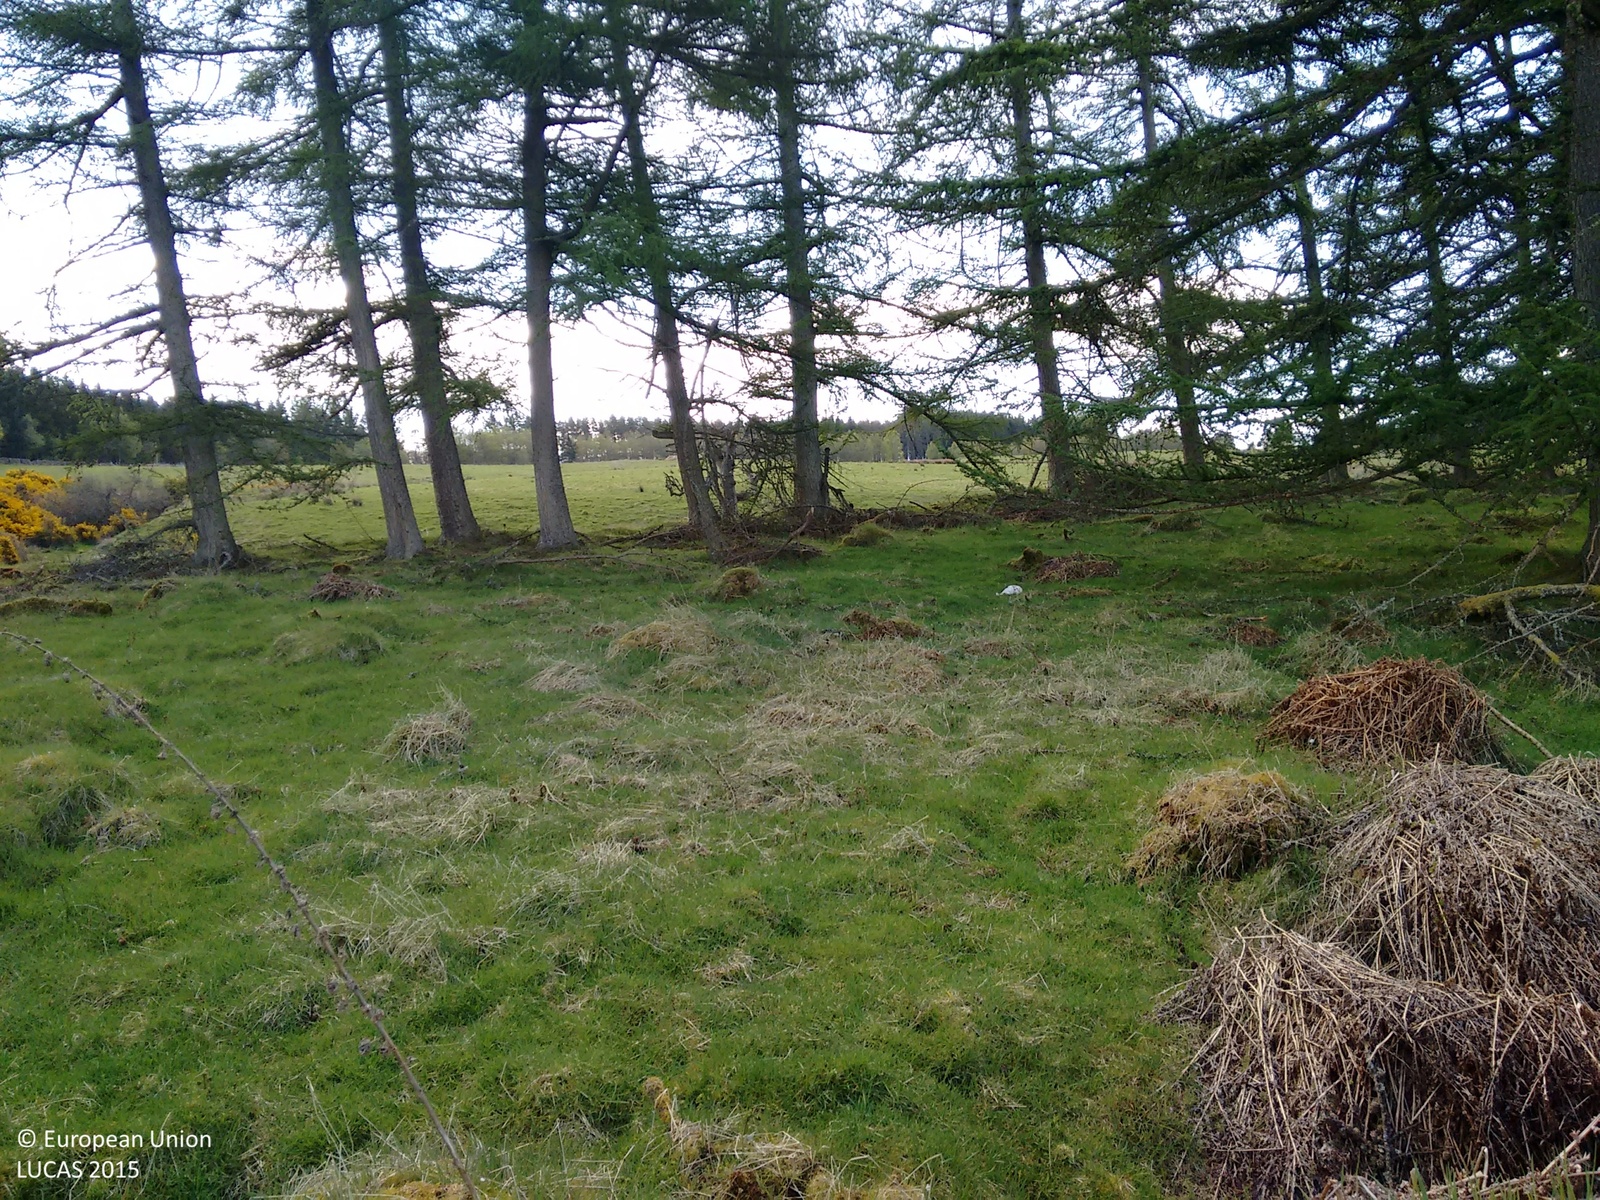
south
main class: Grassland
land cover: Grassland without tree/shrub cover
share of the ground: > 75 %
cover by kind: herbaceous plants 100 %
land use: Agriculture (excluding fallow land and kitchen gardens)
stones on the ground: < 10 %
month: May
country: GB
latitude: 56.2329
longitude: -3.8766
